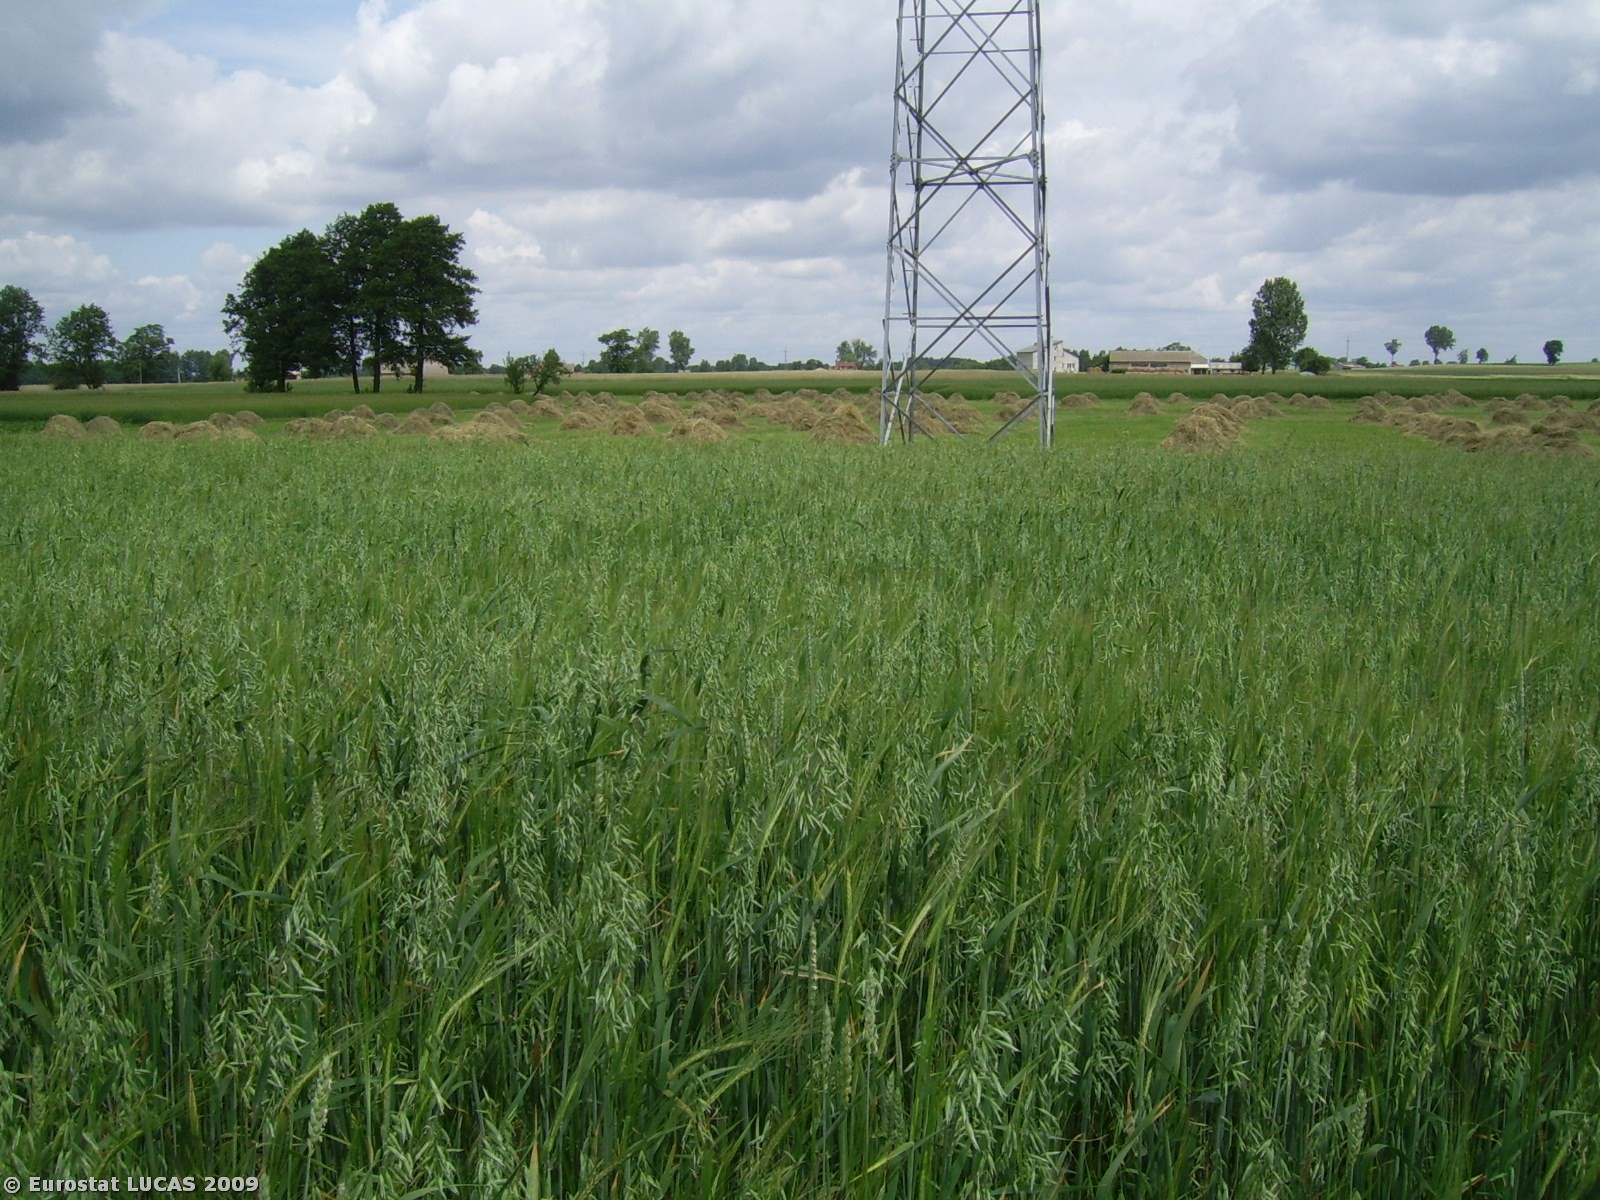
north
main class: Cropland
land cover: Mixed cereals for fodder
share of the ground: > 75 %
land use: Agriculture (excluding fallow land and kitchen gardens)
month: June
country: PL
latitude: 52.4242
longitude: 17.8526
